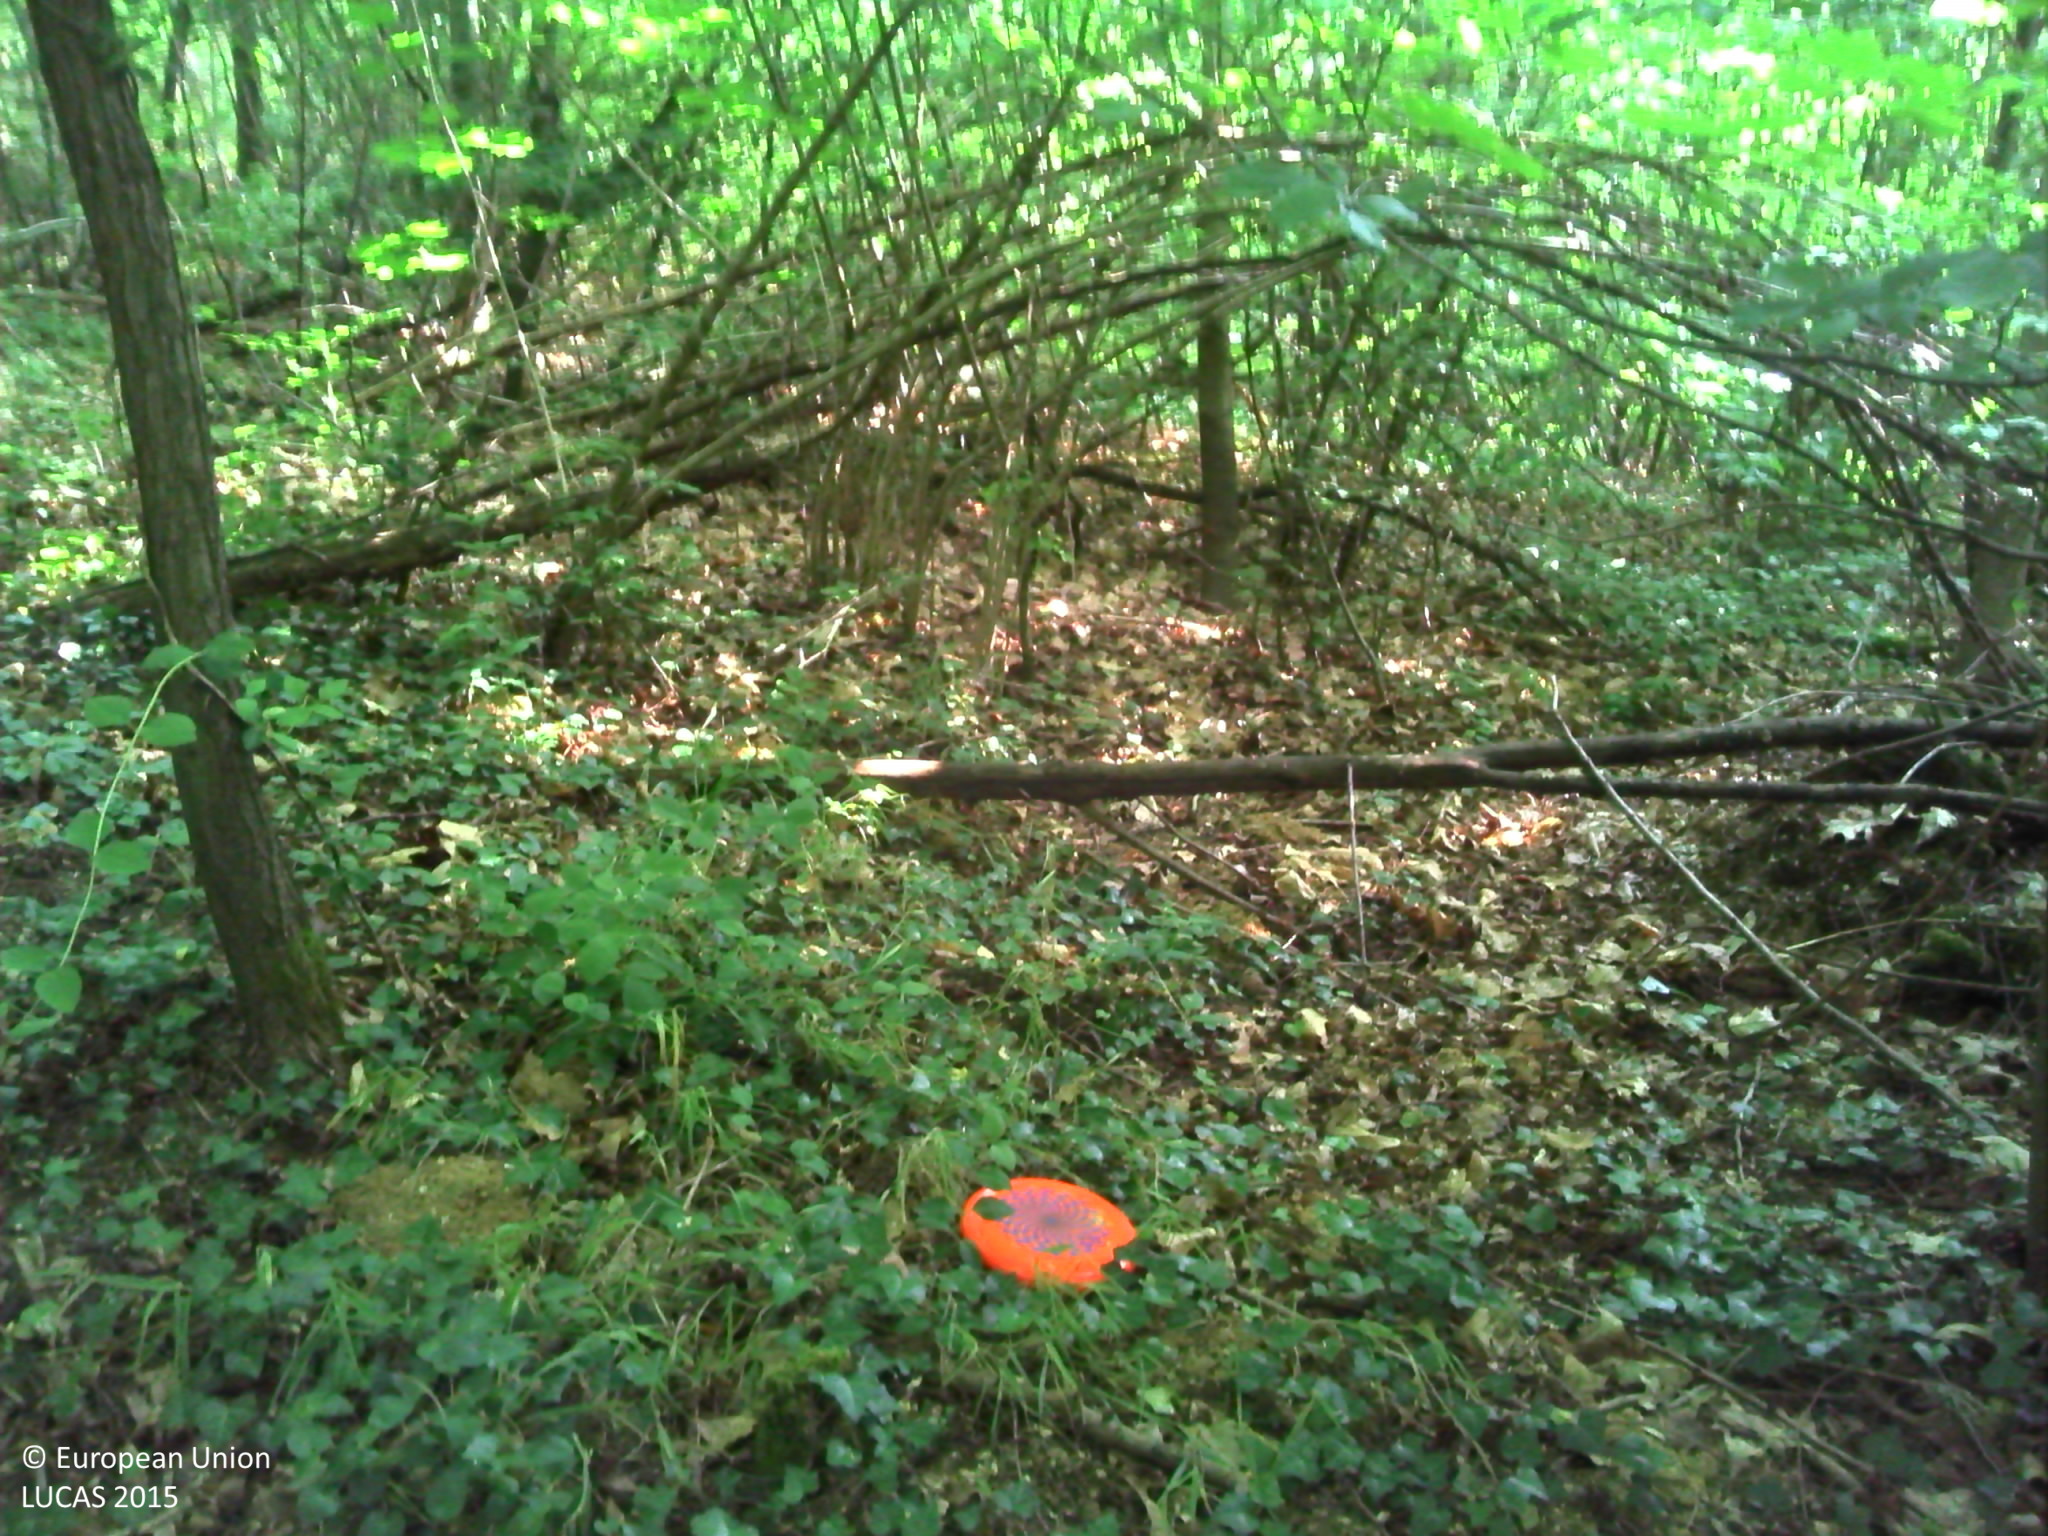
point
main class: Woodland
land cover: Broadleaved woodland
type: acidophilous oak and oak-birch forest
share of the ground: > 75 %
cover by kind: broadleaved forest trees 85 %, herbaceous plants 15 %
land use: Forestry
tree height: > 5 m
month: June
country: FR
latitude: 46.1004
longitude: 4.8414
